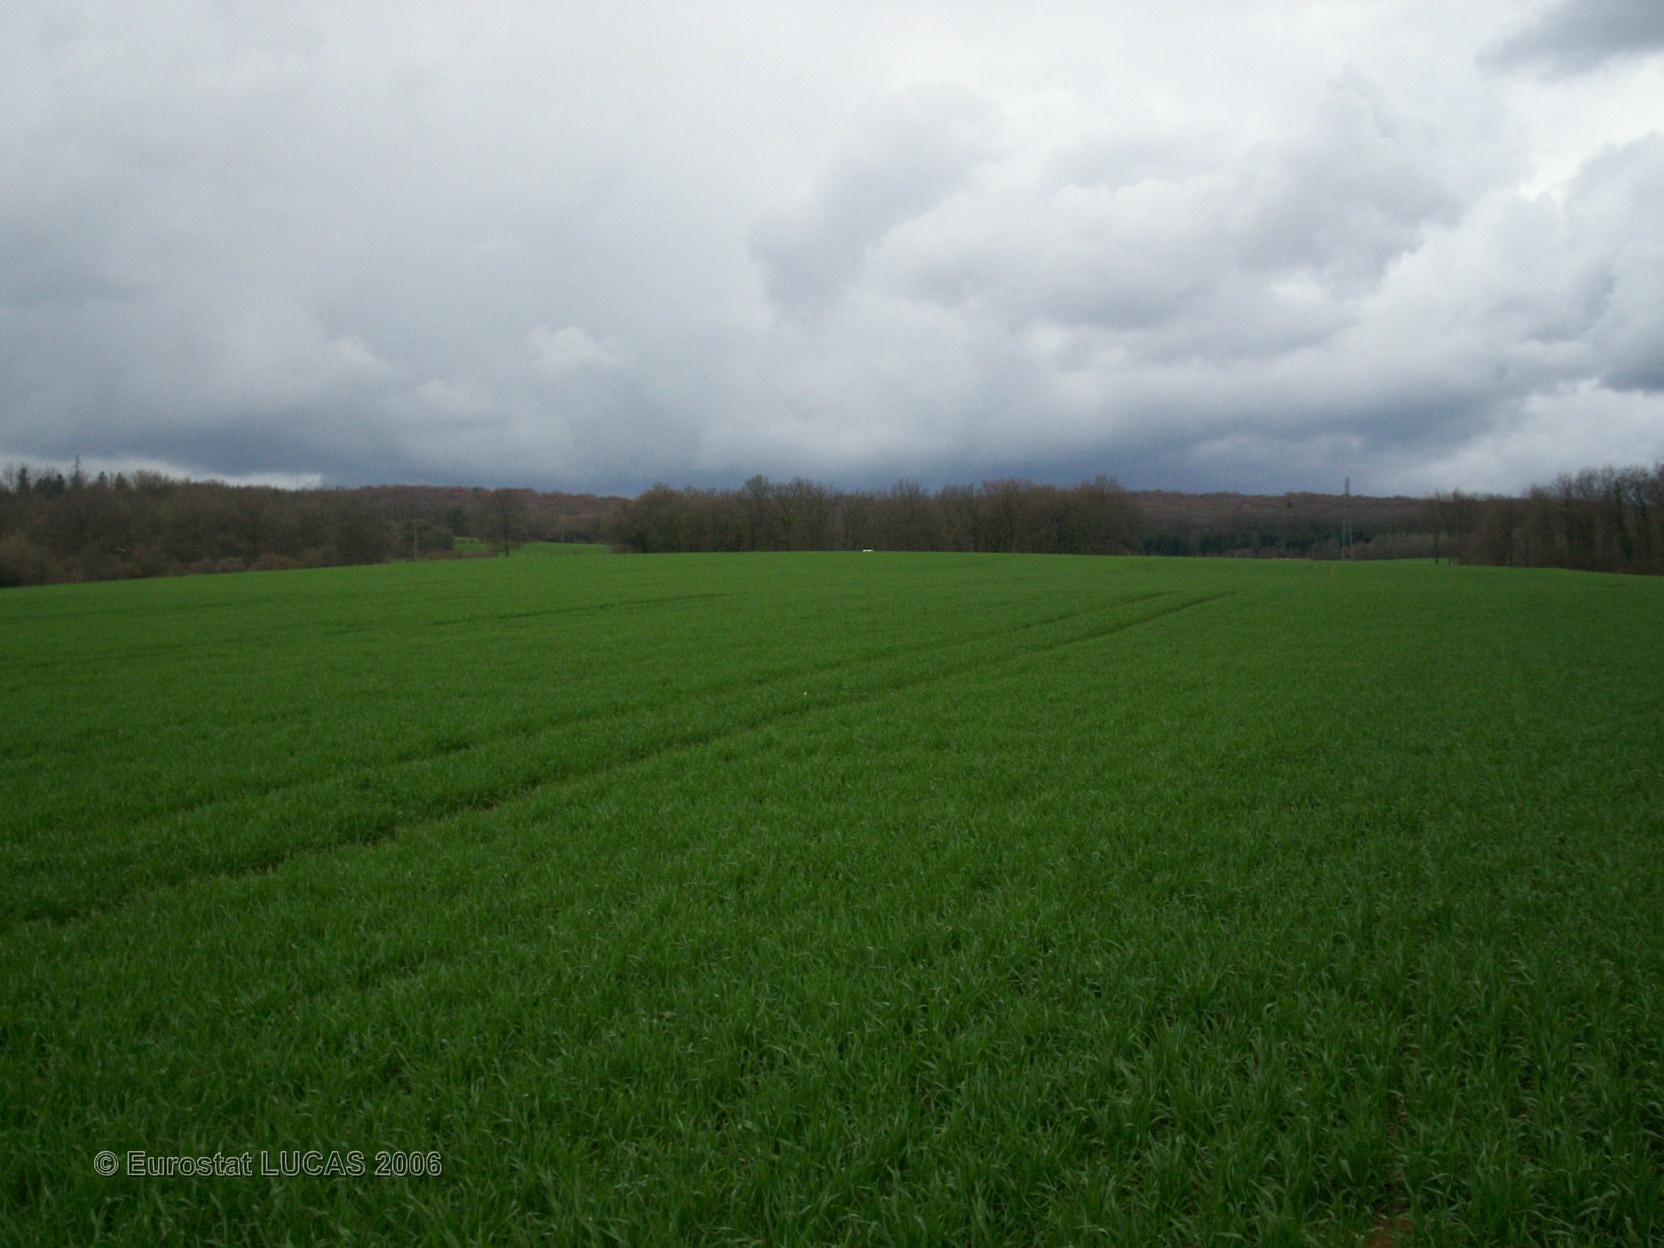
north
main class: Cropland
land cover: Common wheat
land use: Agriculture (excluding fallow land and kitchen gardens)
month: April
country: FR
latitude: 47.5043
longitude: 6.5896
